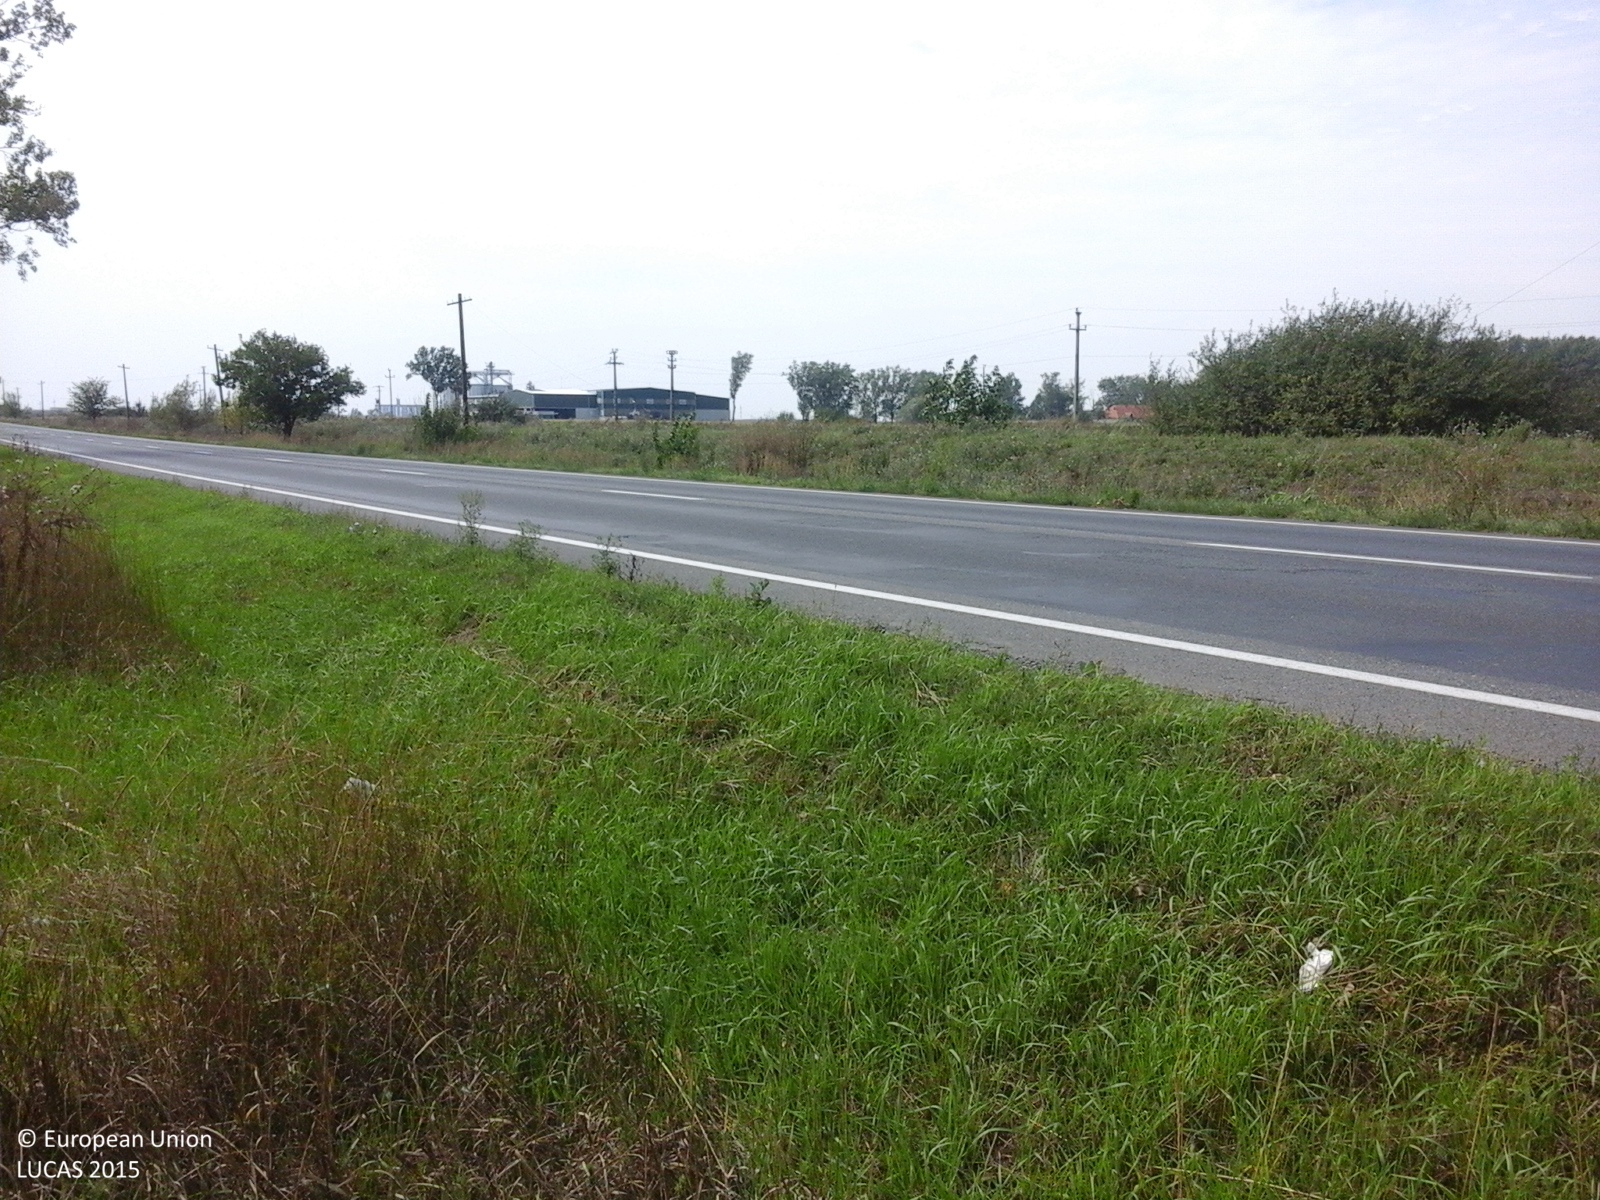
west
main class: Cropland
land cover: Maize
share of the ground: > 75 %
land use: Agriculture (excluding fallow land and kitchen gardens)
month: August
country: RO
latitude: 46.1859
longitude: 21.1350
